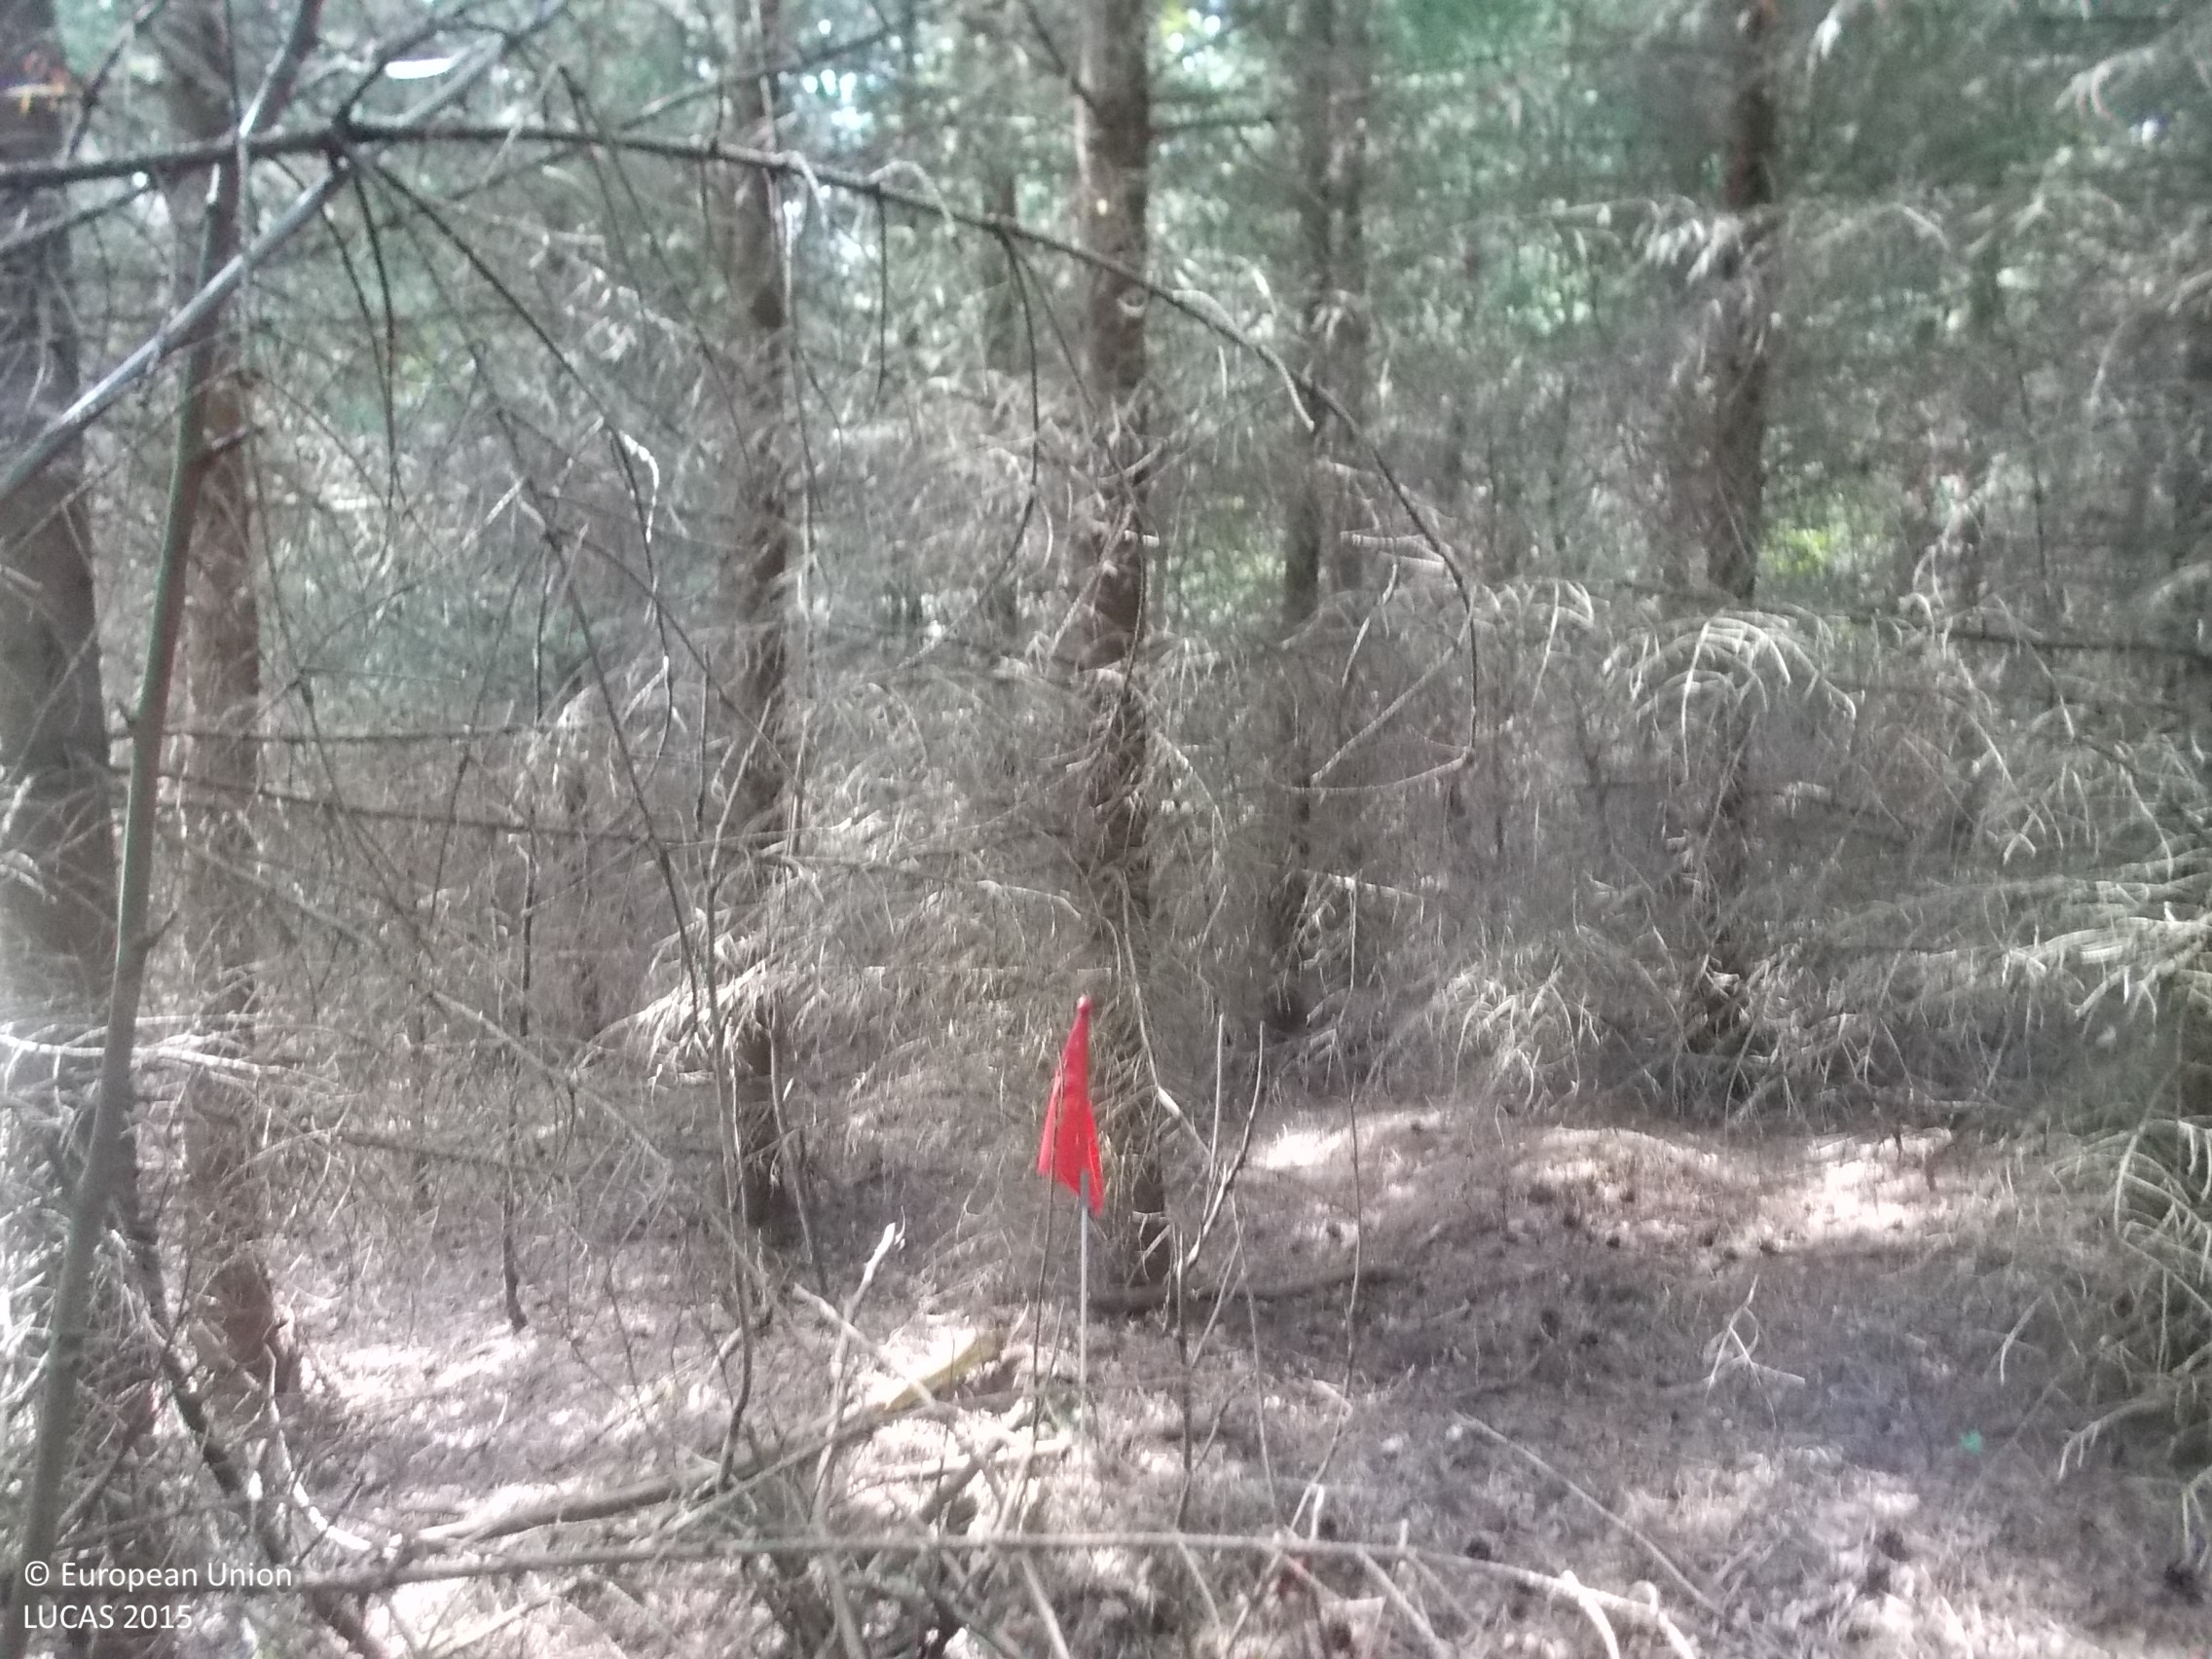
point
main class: Woodland
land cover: Spruce dominated coniferous woodland
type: boreal forest
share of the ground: > 75 %
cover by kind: coniferous forest trees 95 %, lichens and mosses 5 %
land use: Forestry
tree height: > 5 m
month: August
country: SE
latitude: 57.4823
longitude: 13.0814
